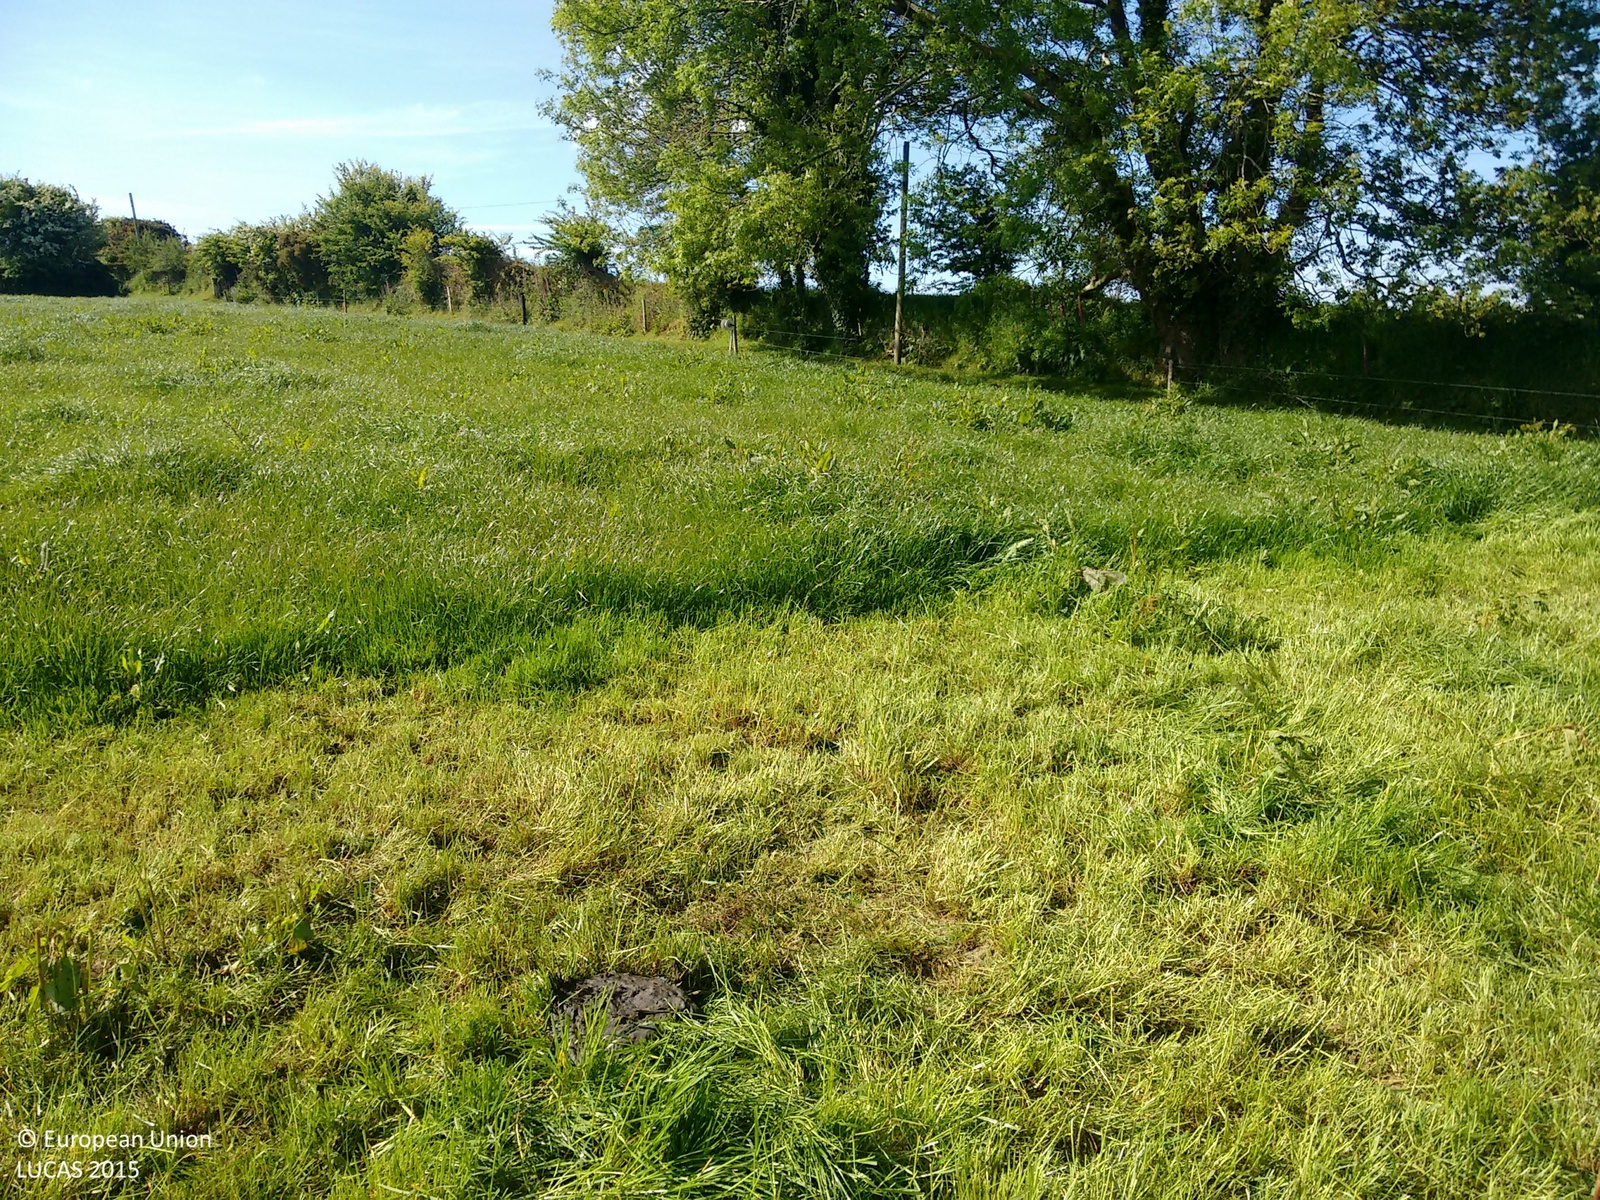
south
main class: Grassland
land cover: Grassland without tree/shrub cover
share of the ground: > 75 %
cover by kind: herbaceous plants 100 %
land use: Agriculture (excluding fallow land and kitchen gardens)
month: June
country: IE
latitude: 51.7837
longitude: -8.7735
